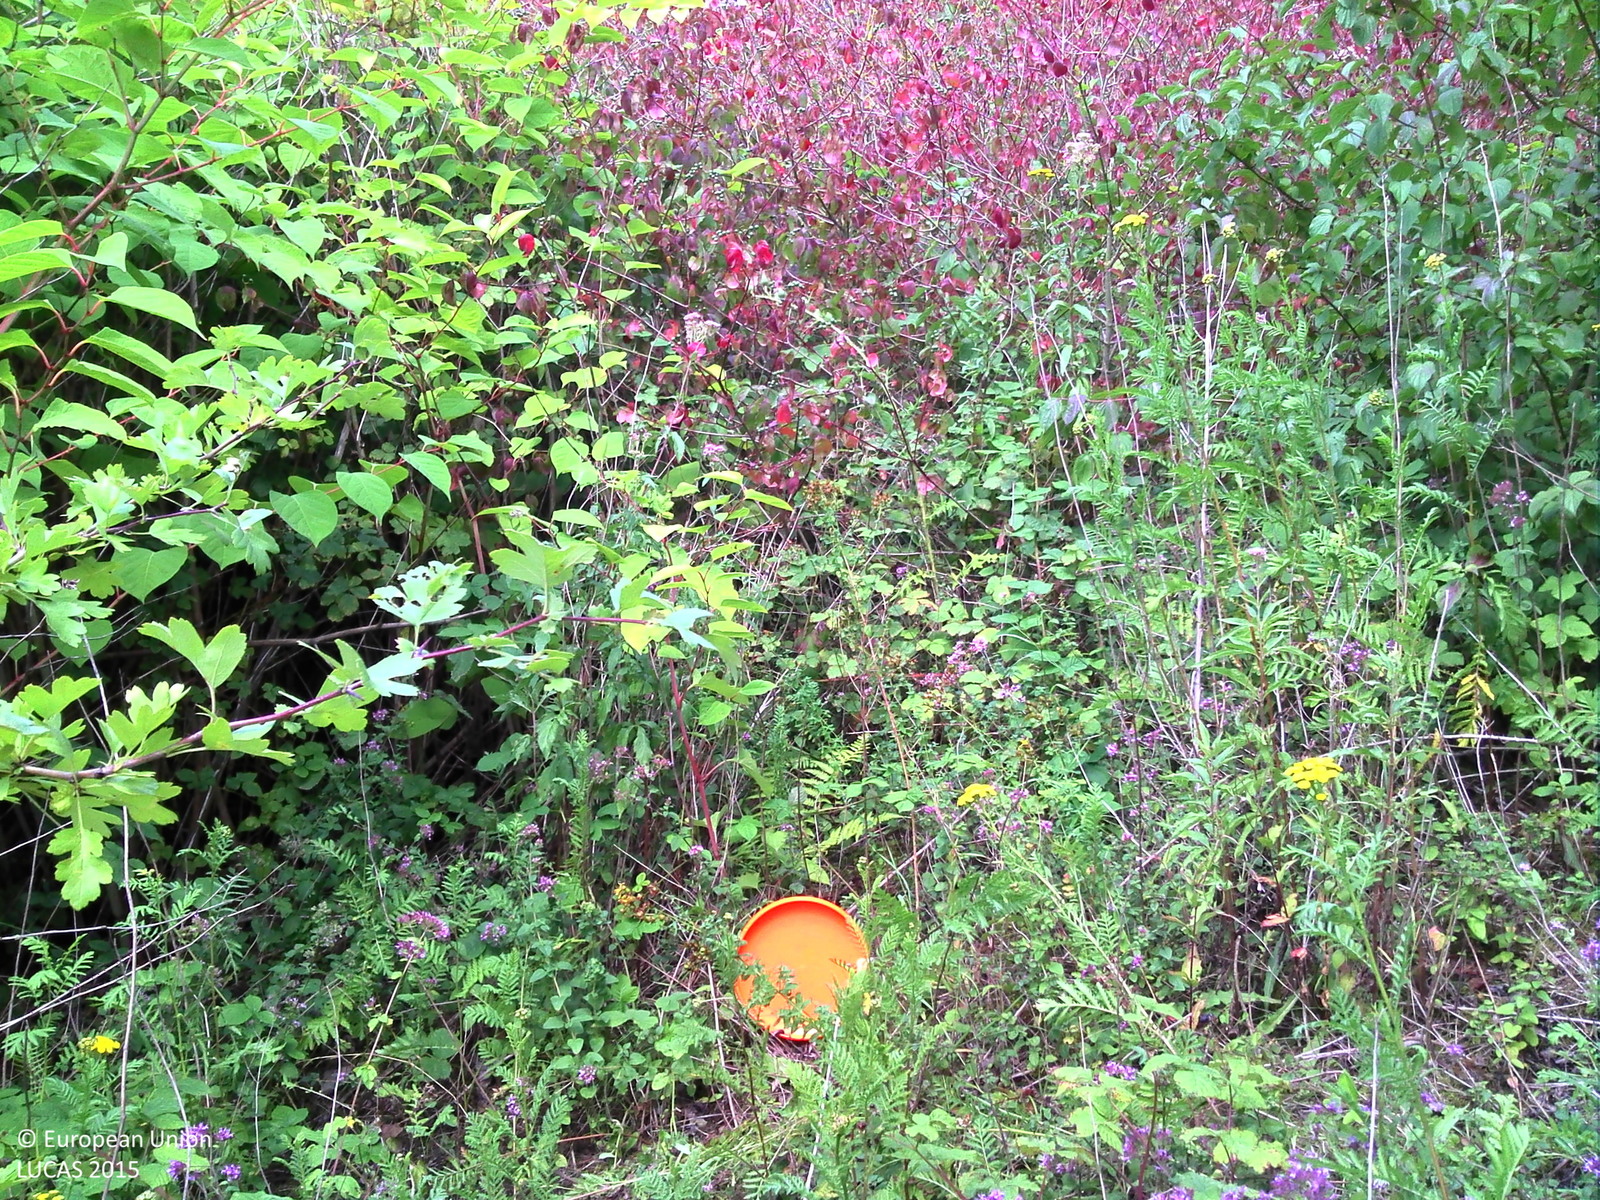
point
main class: Shrubland
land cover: Shrubland with sparse tree cover
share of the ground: > 75 %
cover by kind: shrubs 95 %, broadleaved forest trees 5 %
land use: Semi-natural and natural areas not in use
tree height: > 5 m
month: July
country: BE
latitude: 50.6353
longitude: 5.4879
